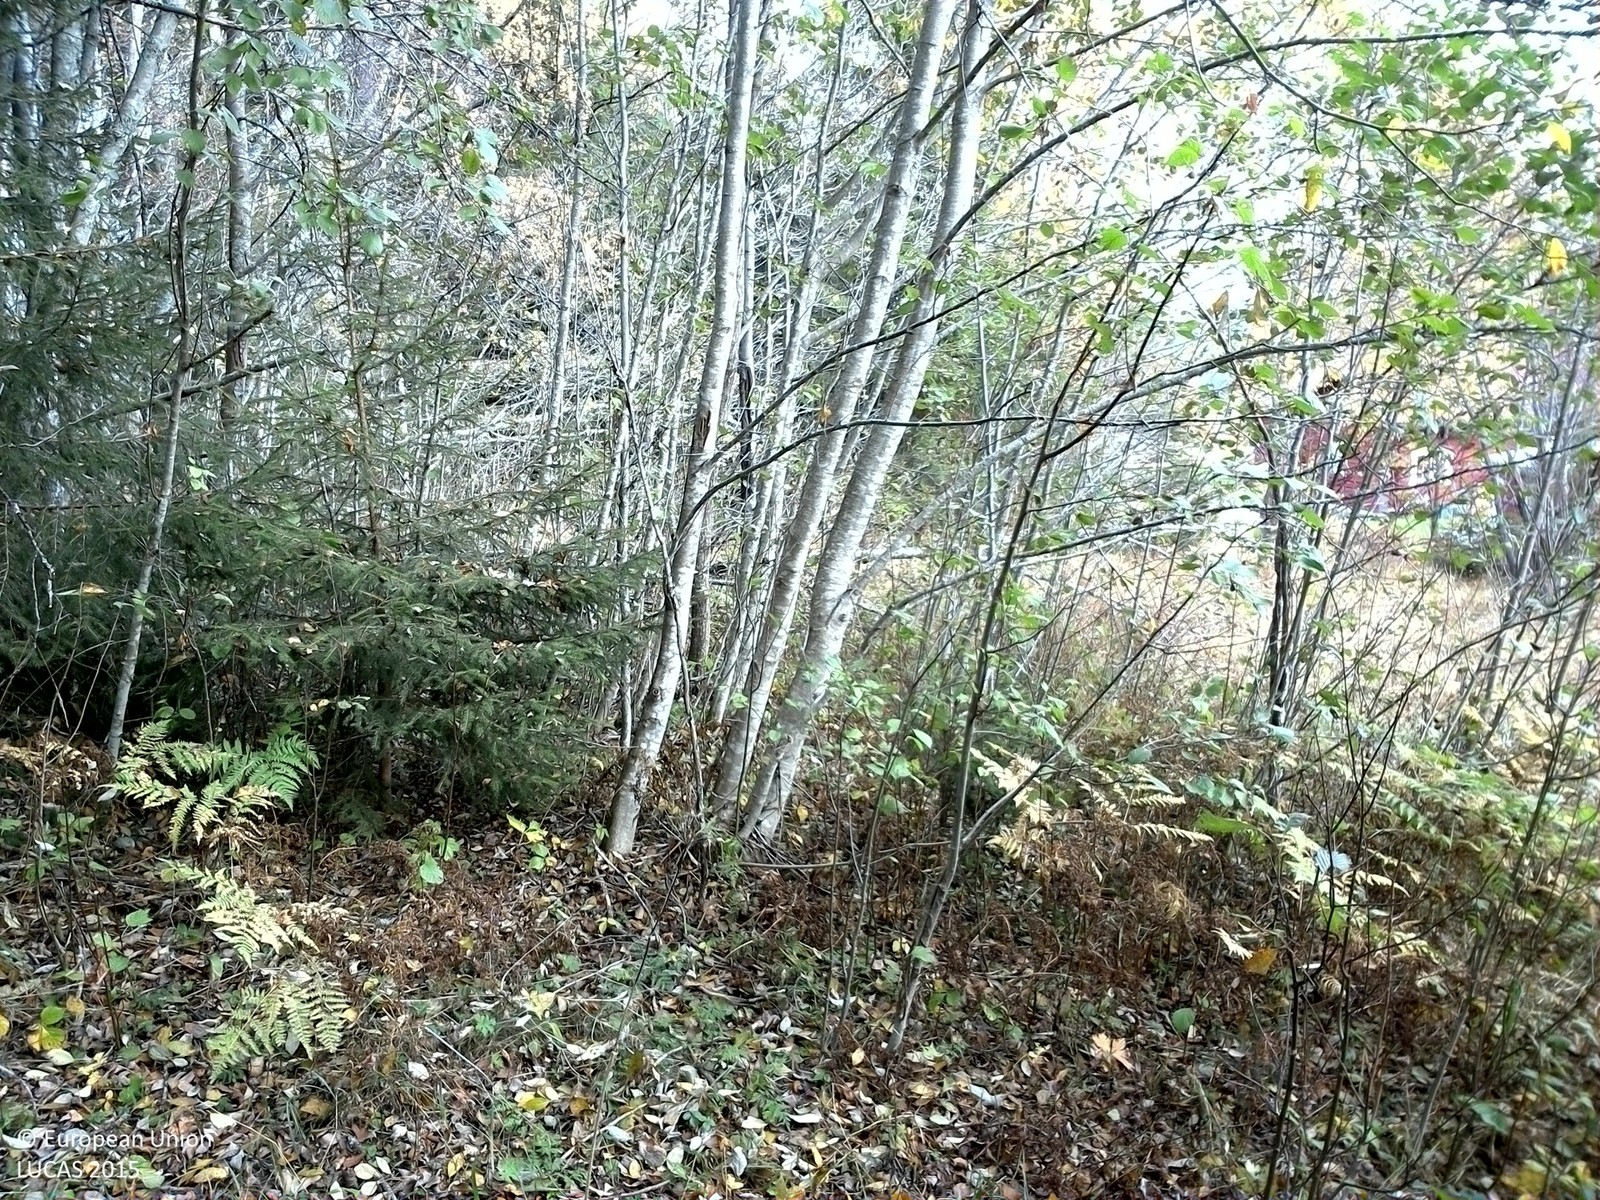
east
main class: Woodland
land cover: Broadleaved woodland
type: hemiboreal forest and nemoral coniferous forest and mixed broadleaved-coniferous forest
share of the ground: > 75 %
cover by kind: broadleaved forest trees 70 %, herbaceous plants 25 %, coniferous forest trees 5 %
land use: Forestry
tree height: > 5 m
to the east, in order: Broadleaved woodland; Spruce dominated mixed woodland; Grassland with sparse tree/shrub cover; Broadleaved woodland; Grassland without tree/shrub cover; Broadleaved woodland; Ditches and canals; Grassland without tree/shrub cover; Paved roads, cycling and walking lanes; Grassland without tree/shrub cover; Electric lines; Grassland with sparse tree/shrub cover
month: October
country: SE
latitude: 61.1696
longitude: 14.6149
